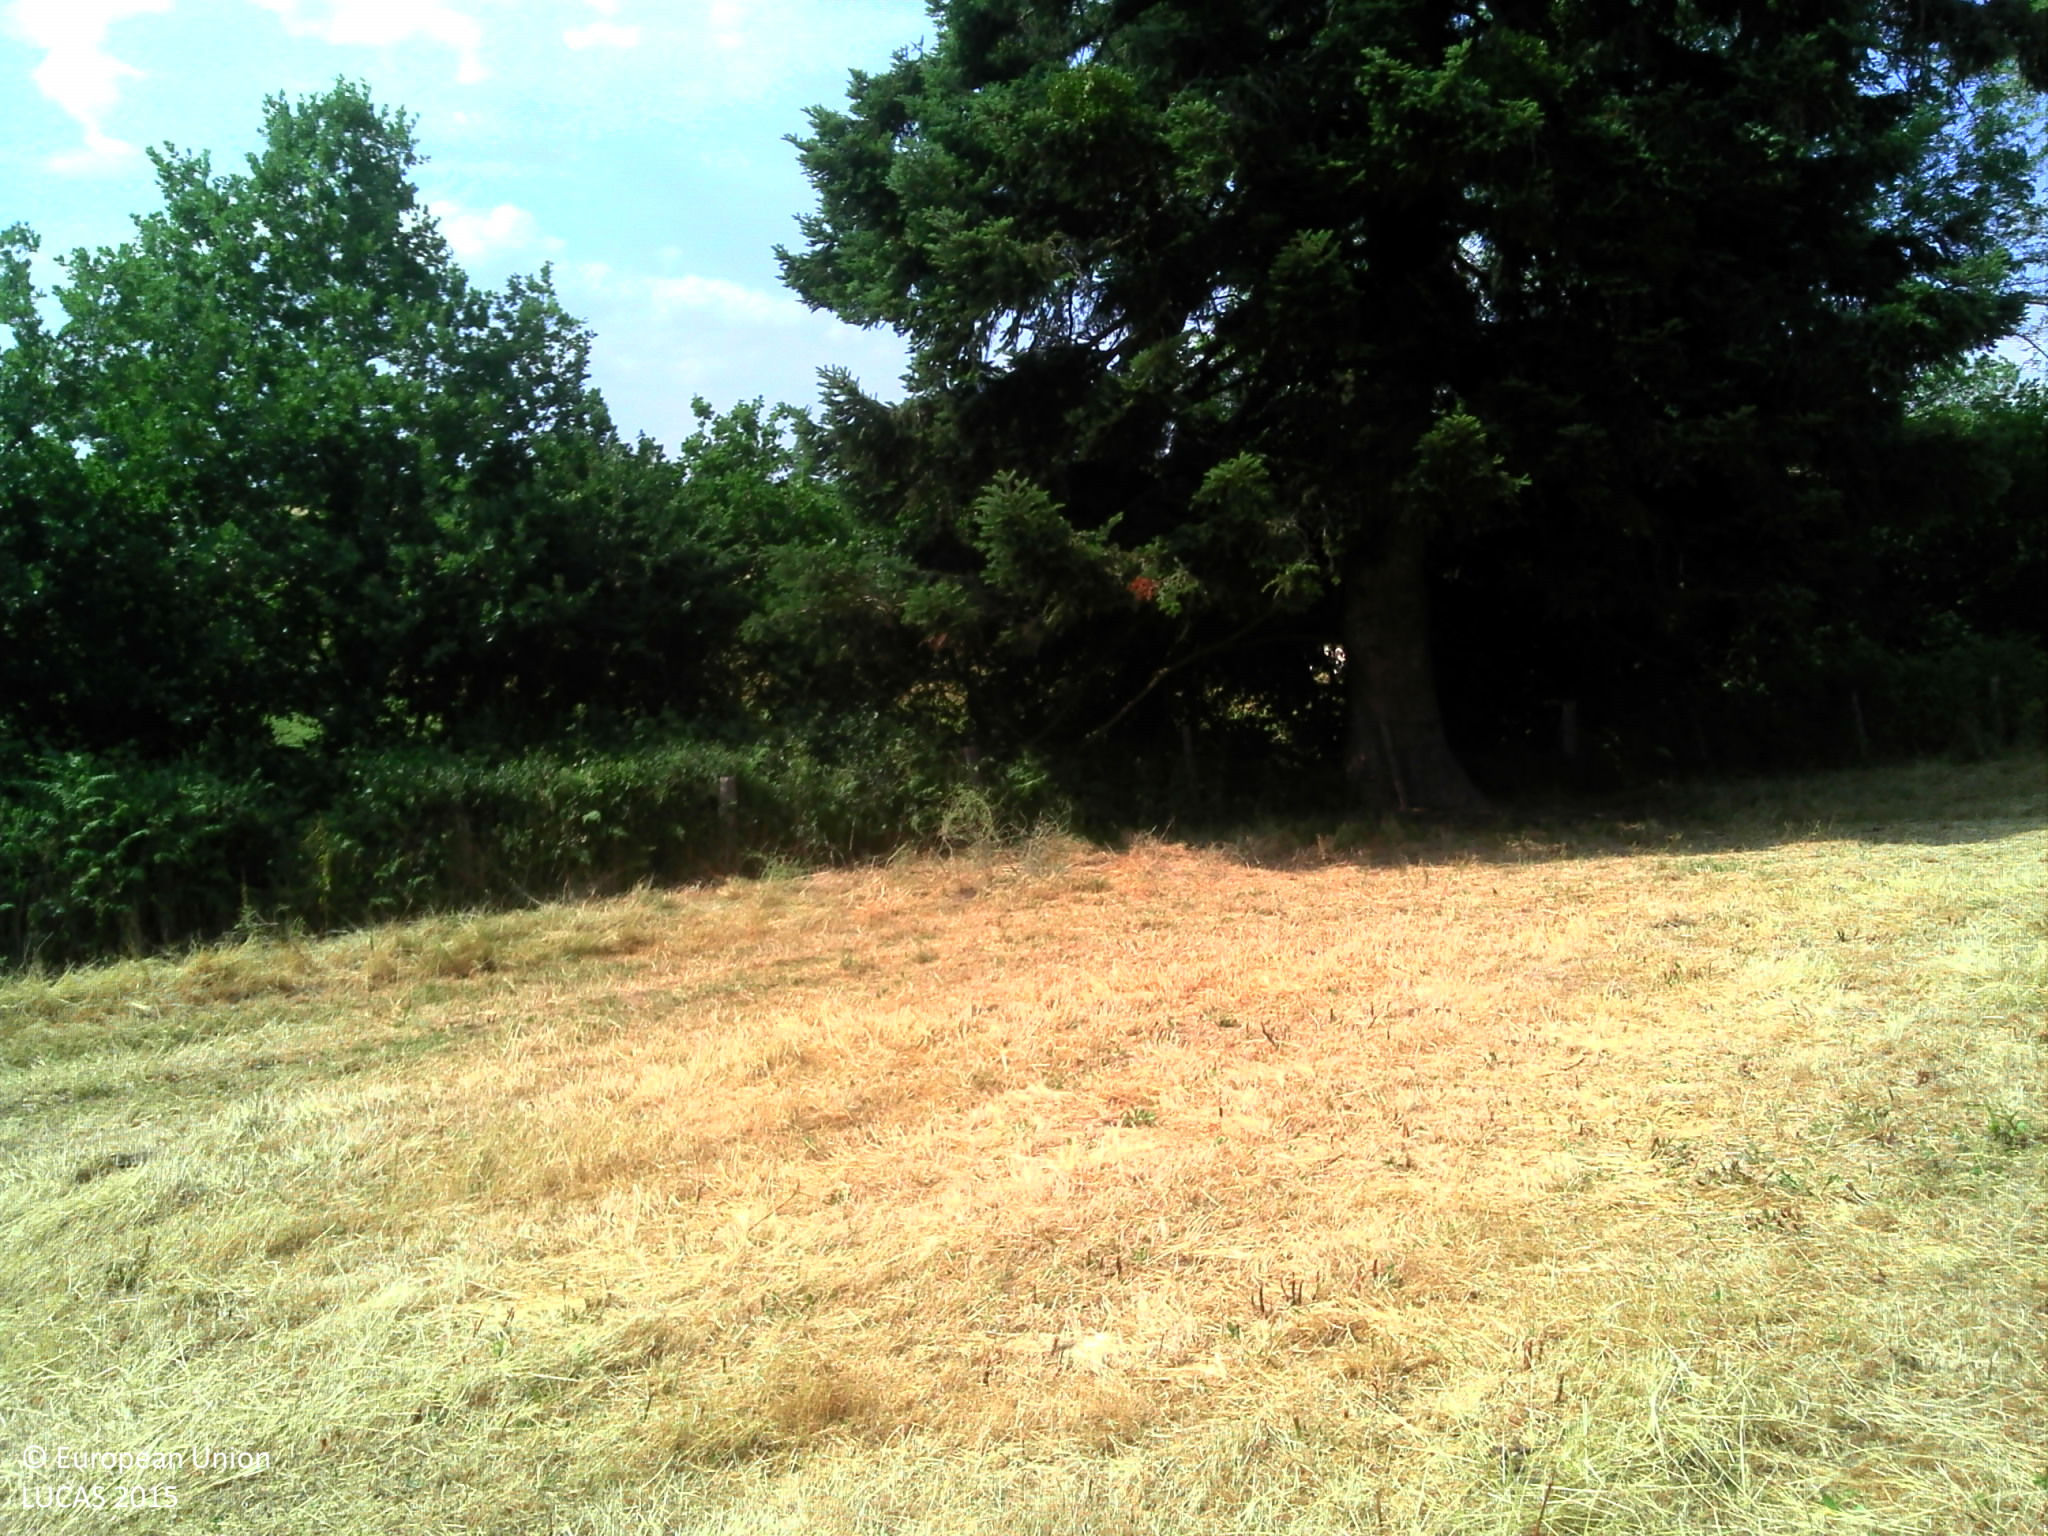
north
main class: Grassland
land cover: Grassland without tree/shrub cover
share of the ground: > 75 %
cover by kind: herbaceous plants 100 %
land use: Agriculture (excluding fallow land and kitchen gardens)
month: June
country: FR
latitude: 46.3670
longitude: 4.3990
